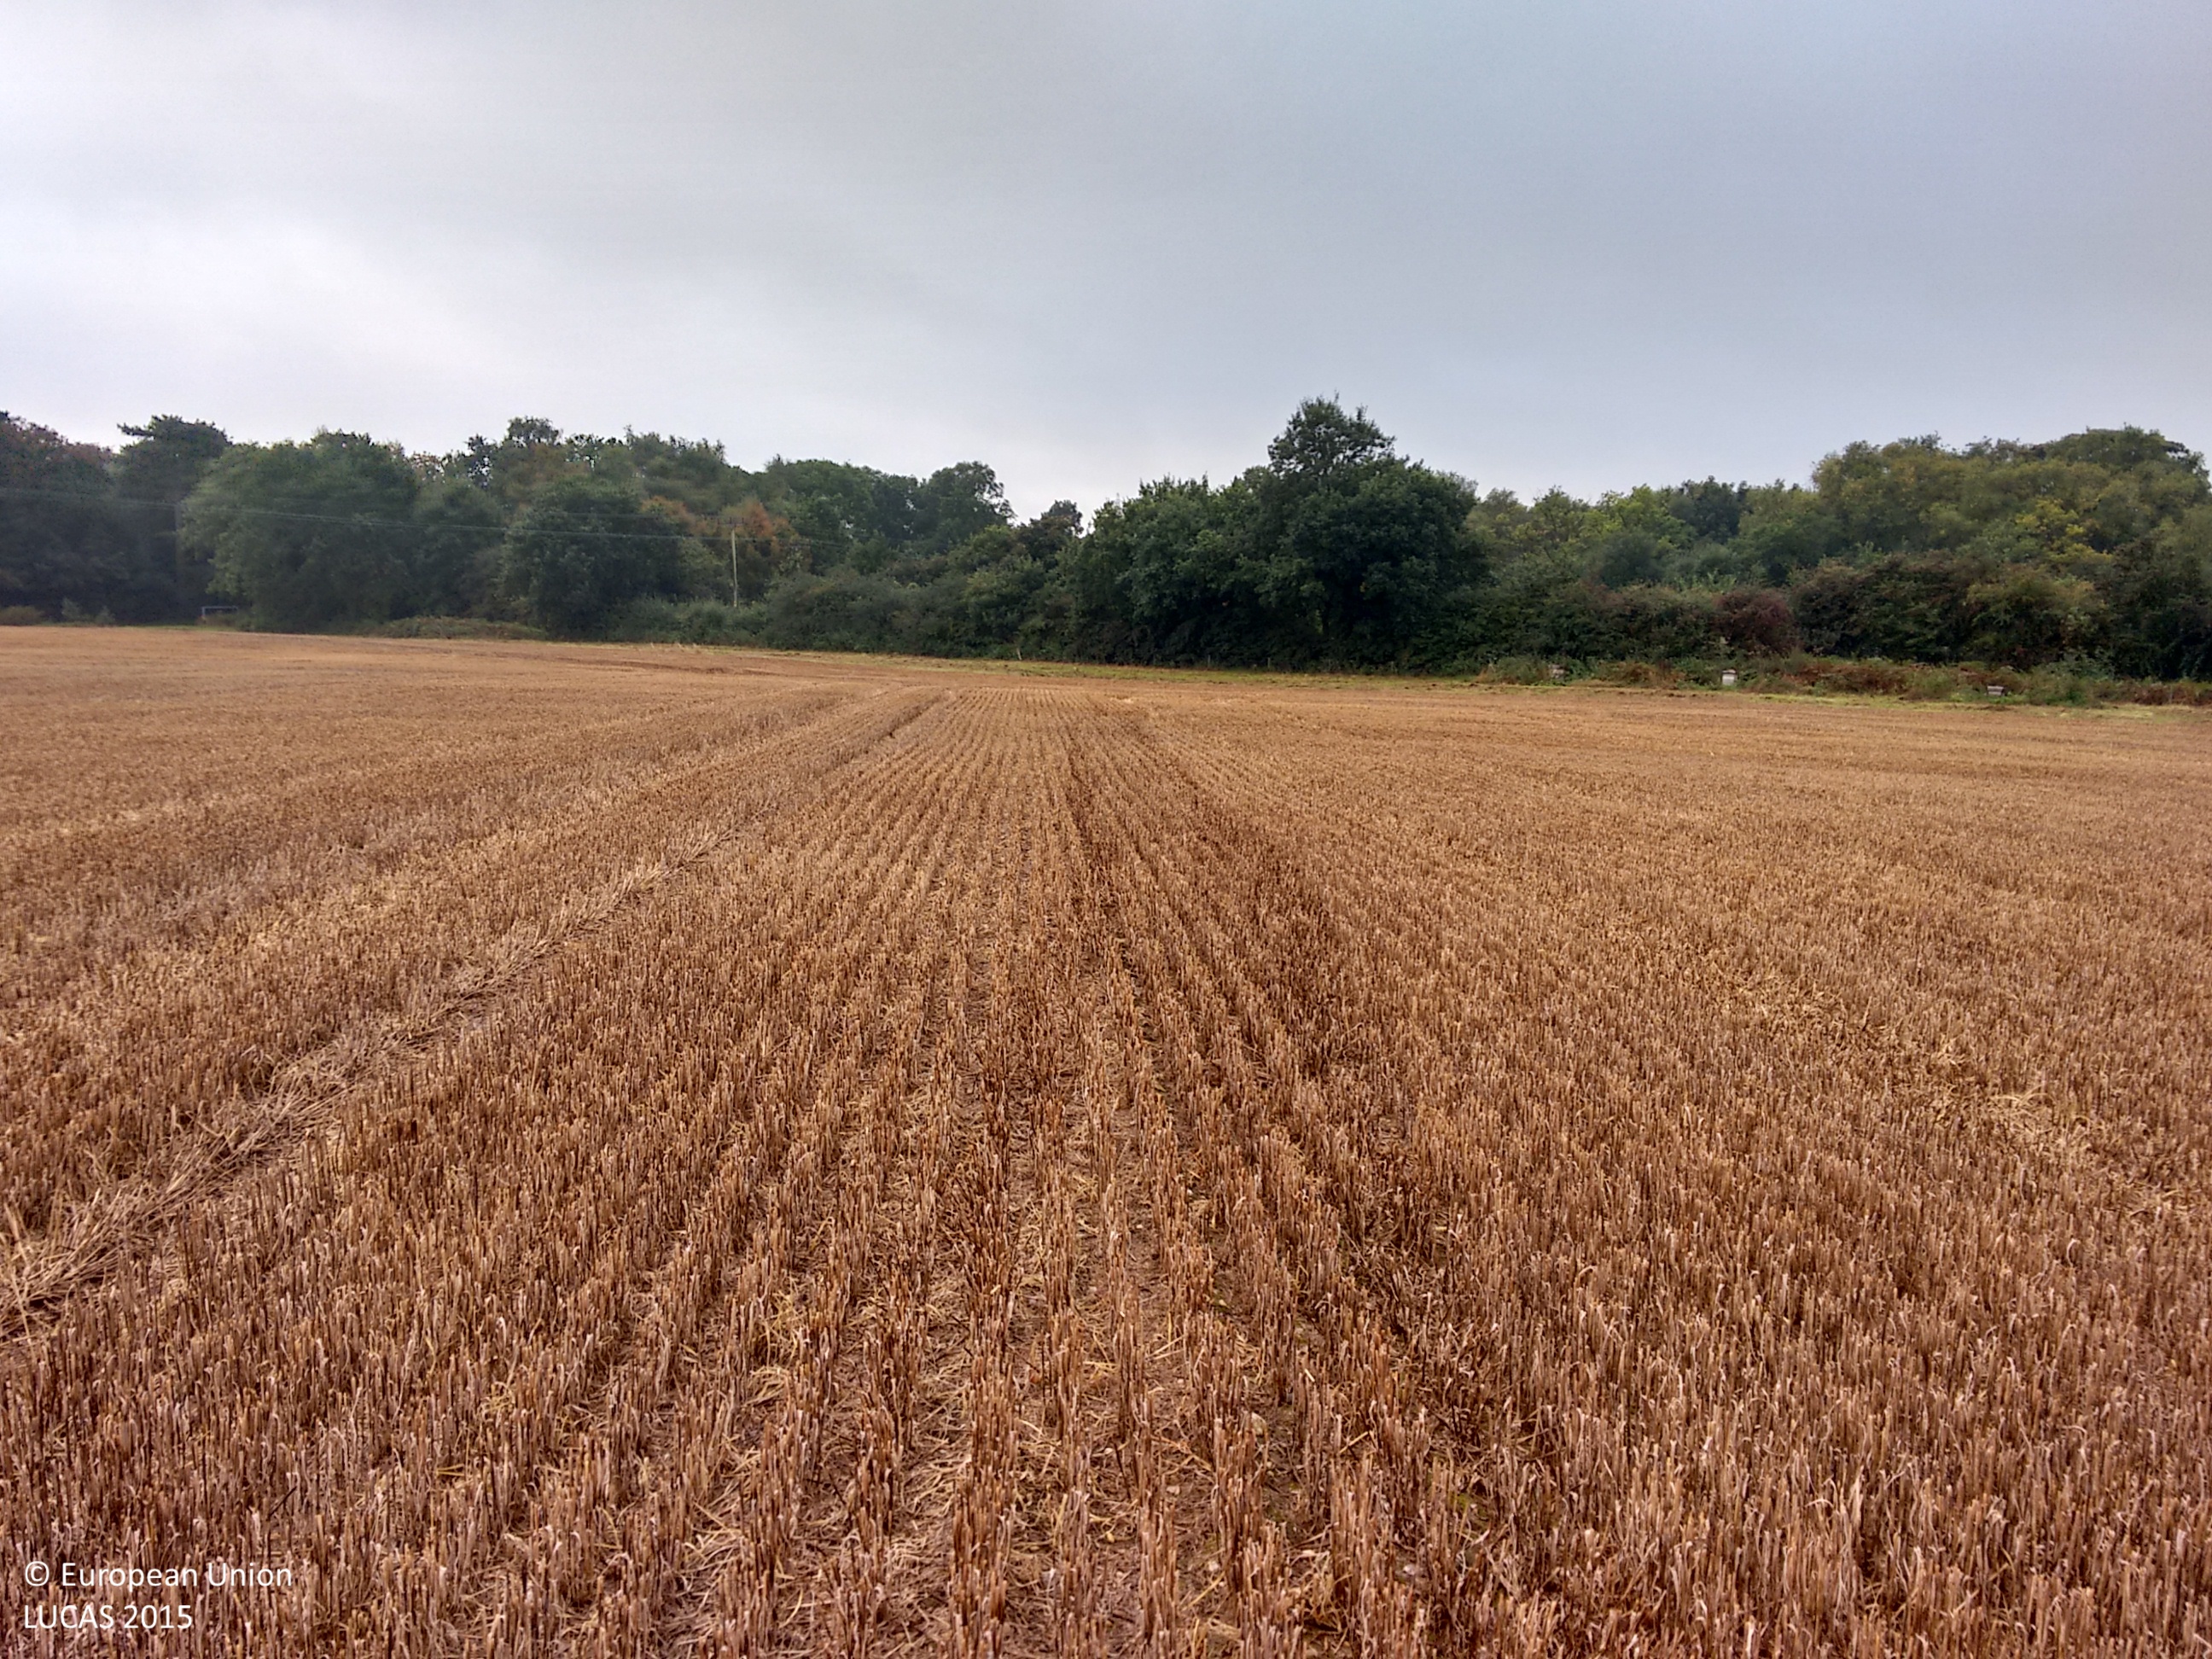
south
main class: Cropland
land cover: Common wheat
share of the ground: > 75 %
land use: Agriculture (excluding fallow land and kitchen gardens)
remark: Harvested field
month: October
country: GB
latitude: 52.5391
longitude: 1.7112
